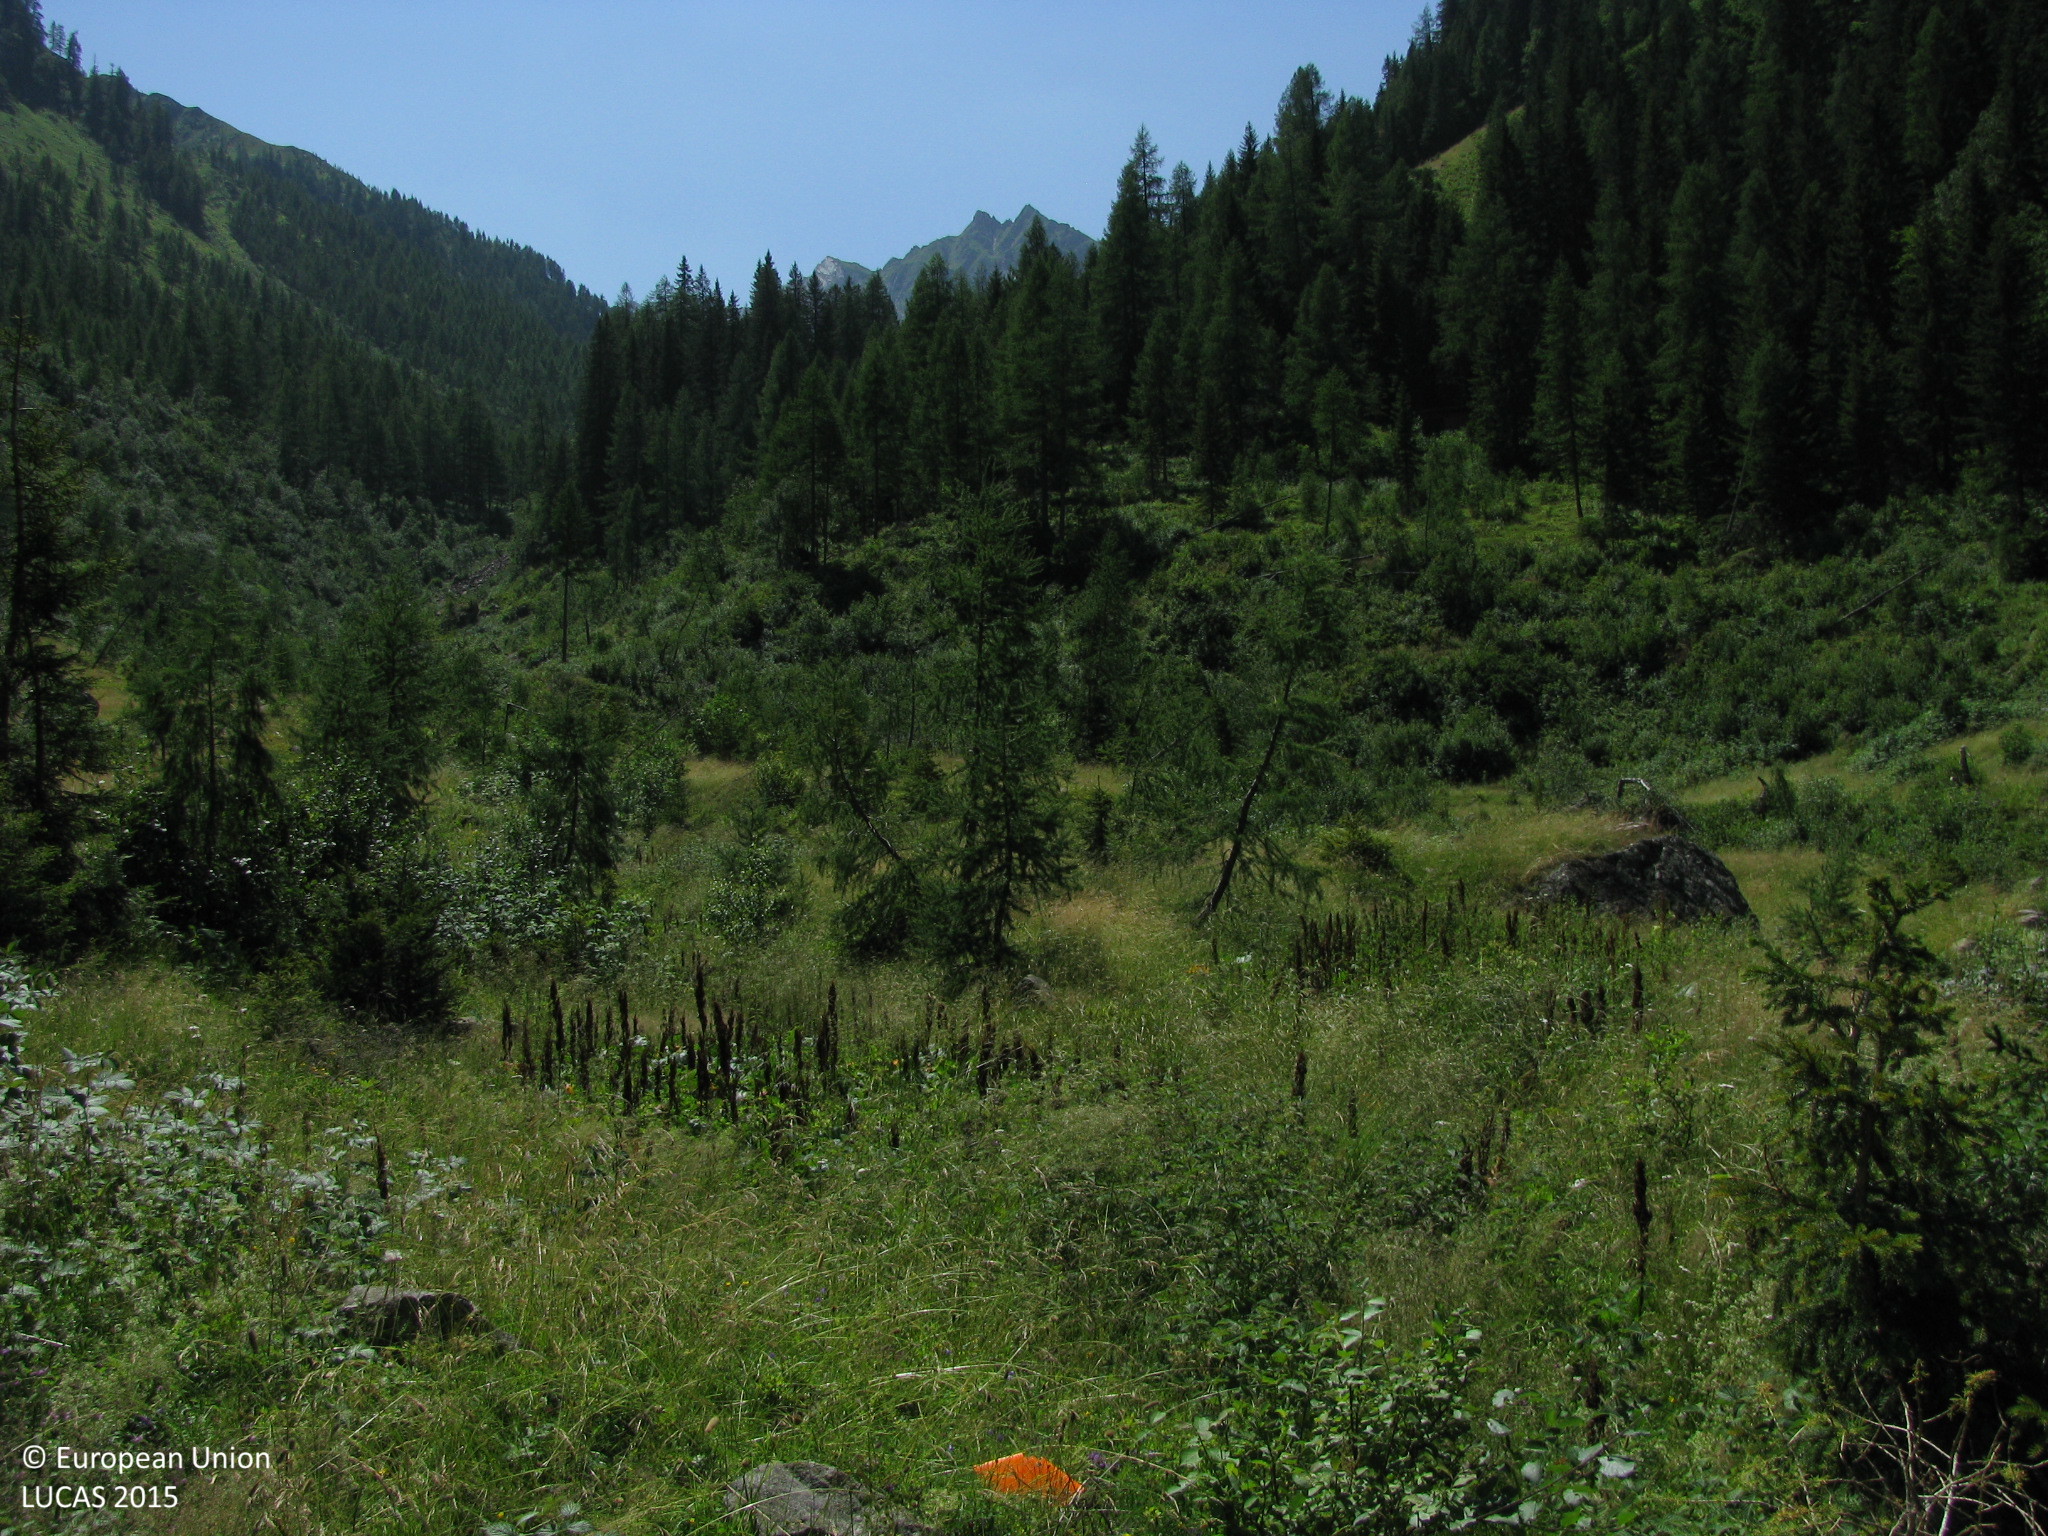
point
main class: Shrubland
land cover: Shrubland with sparse tree cover
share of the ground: > 75 %
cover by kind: herbaceous plants 70 %, shrubs 20 %, coniferous forest trees 5 %, consolidated bare surface 5 %
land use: Forestry
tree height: < 5 m
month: July
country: AT
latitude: 46.6581
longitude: 12.7547
